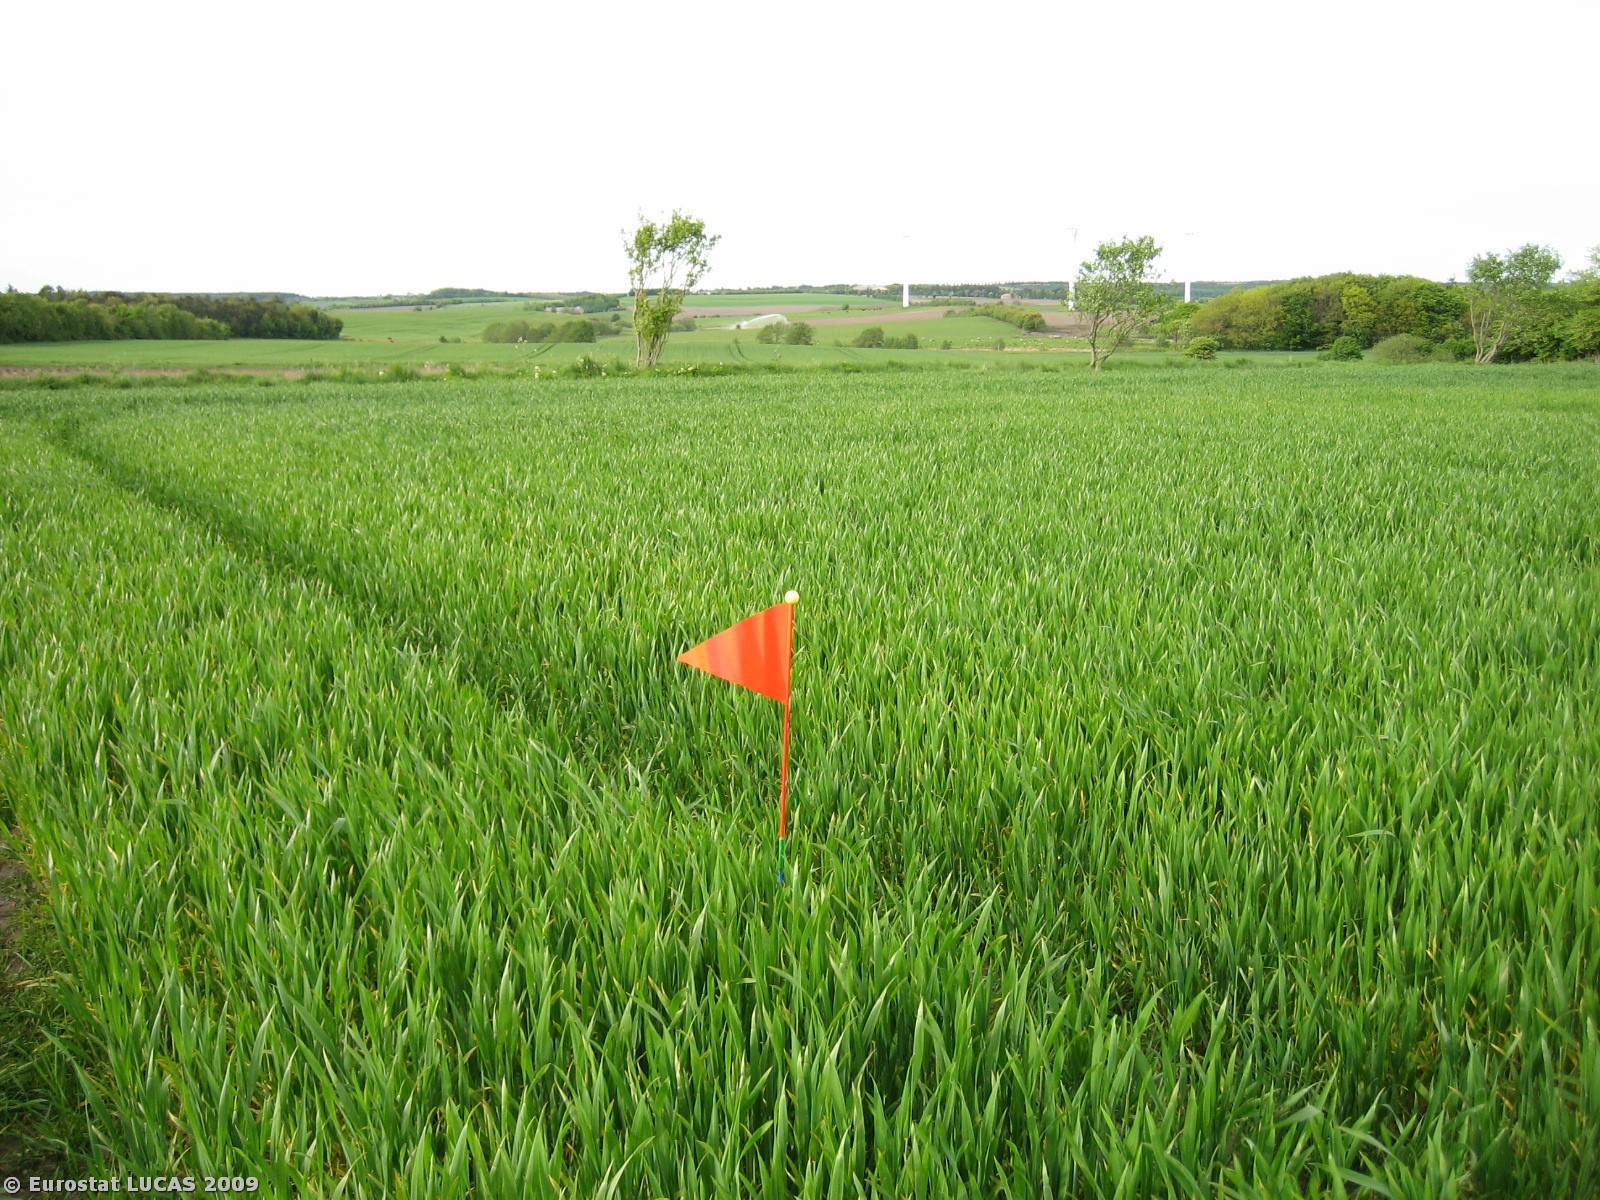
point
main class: Cropland
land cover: Common wheat
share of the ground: > 75 %
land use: Agriculture (excluding fallow land and kitchen gardens)
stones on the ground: < 10 %
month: May
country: DK
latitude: 56.1247
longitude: 8.4734
